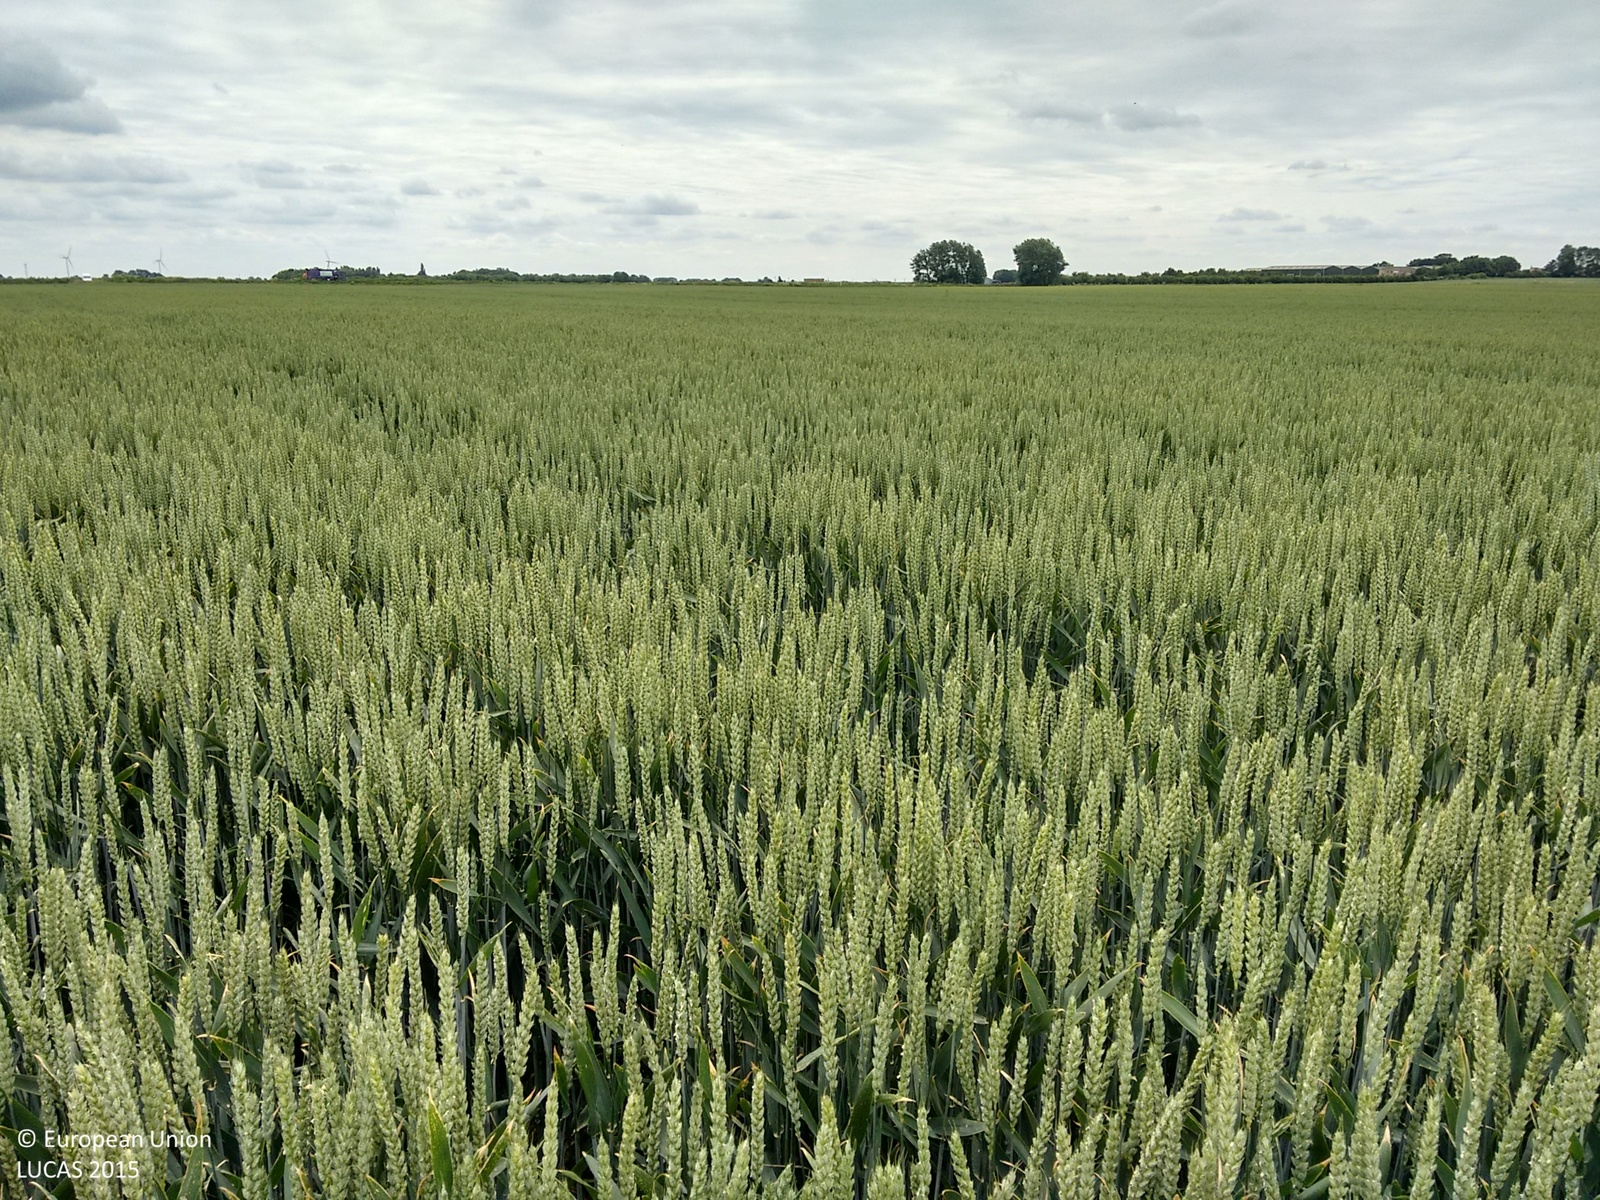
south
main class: Cropland
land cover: Common wheat
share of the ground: > 75 %
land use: Agriculture (excluding fallow land and kitchen gardens)
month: June
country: GB
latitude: 52.5660
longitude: -0.0503
